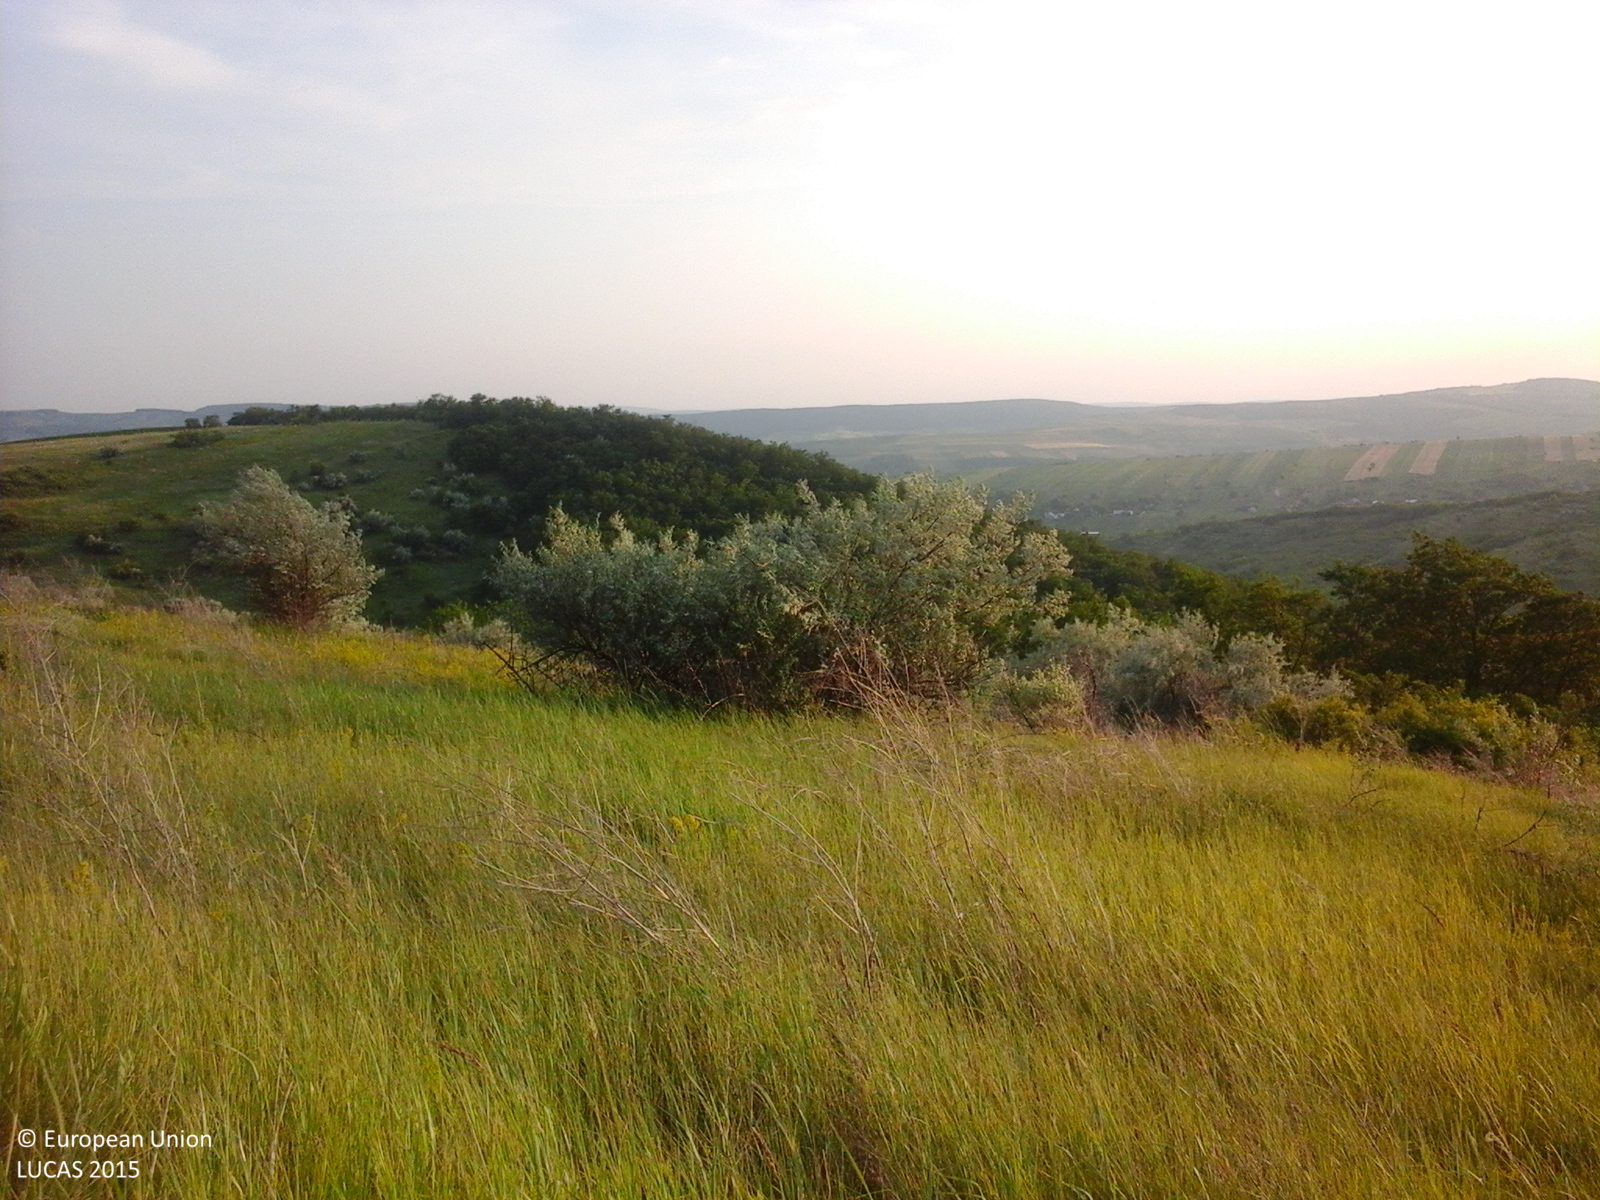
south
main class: Grassland
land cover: Grassland with sparse tree/shrub cover
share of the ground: > 75 %
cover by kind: herbaceous plants 90 %, broadleaved forest trees 5 %, shrubs 5 %
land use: Agriculture (excluding fallow land and kitchen gardens)
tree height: < 5 m
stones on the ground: 10 - 25 %
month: June
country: RO
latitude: 46.6906
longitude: 27.4359
